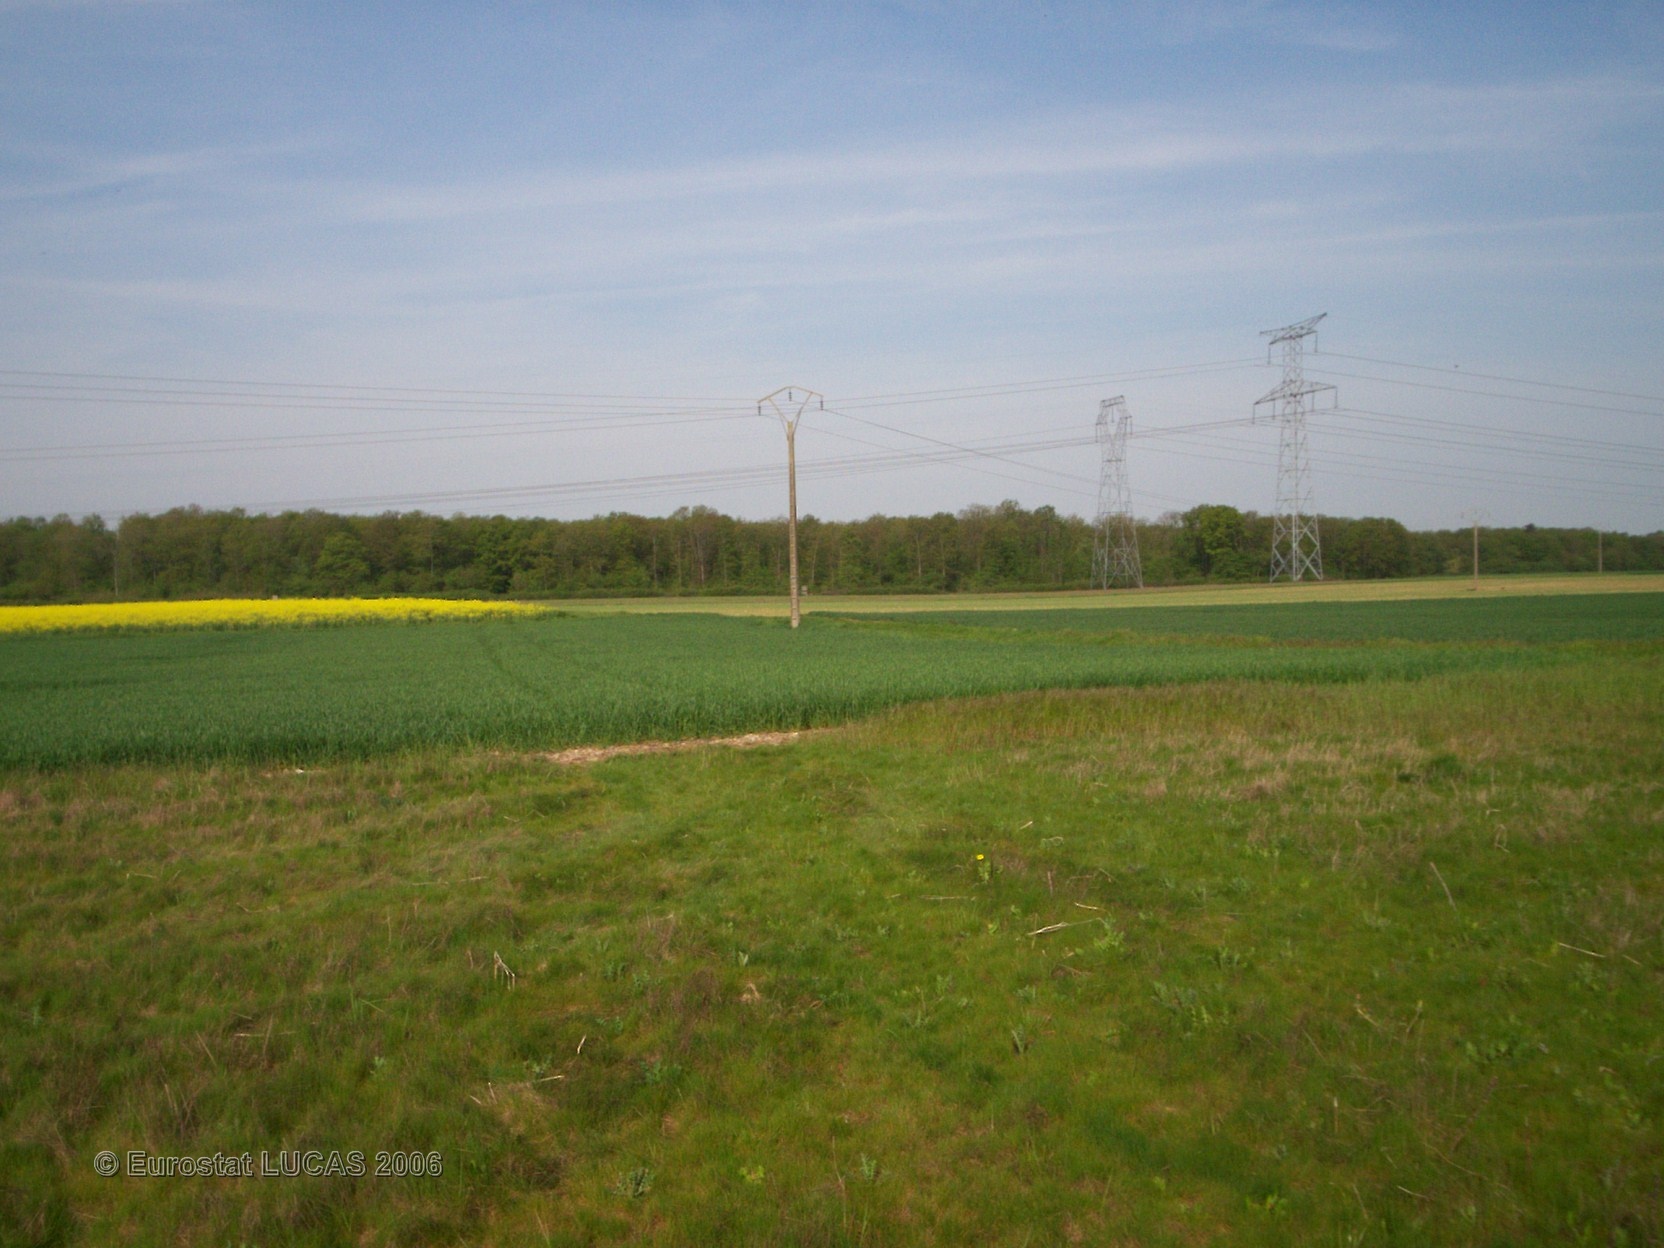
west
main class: Grassland
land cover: Grassland without tree/shrub cover
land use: Agriculture (excluding fallow land and kitchen gardens)
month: May
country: FR
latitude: 48.0825
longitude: 2.8640
